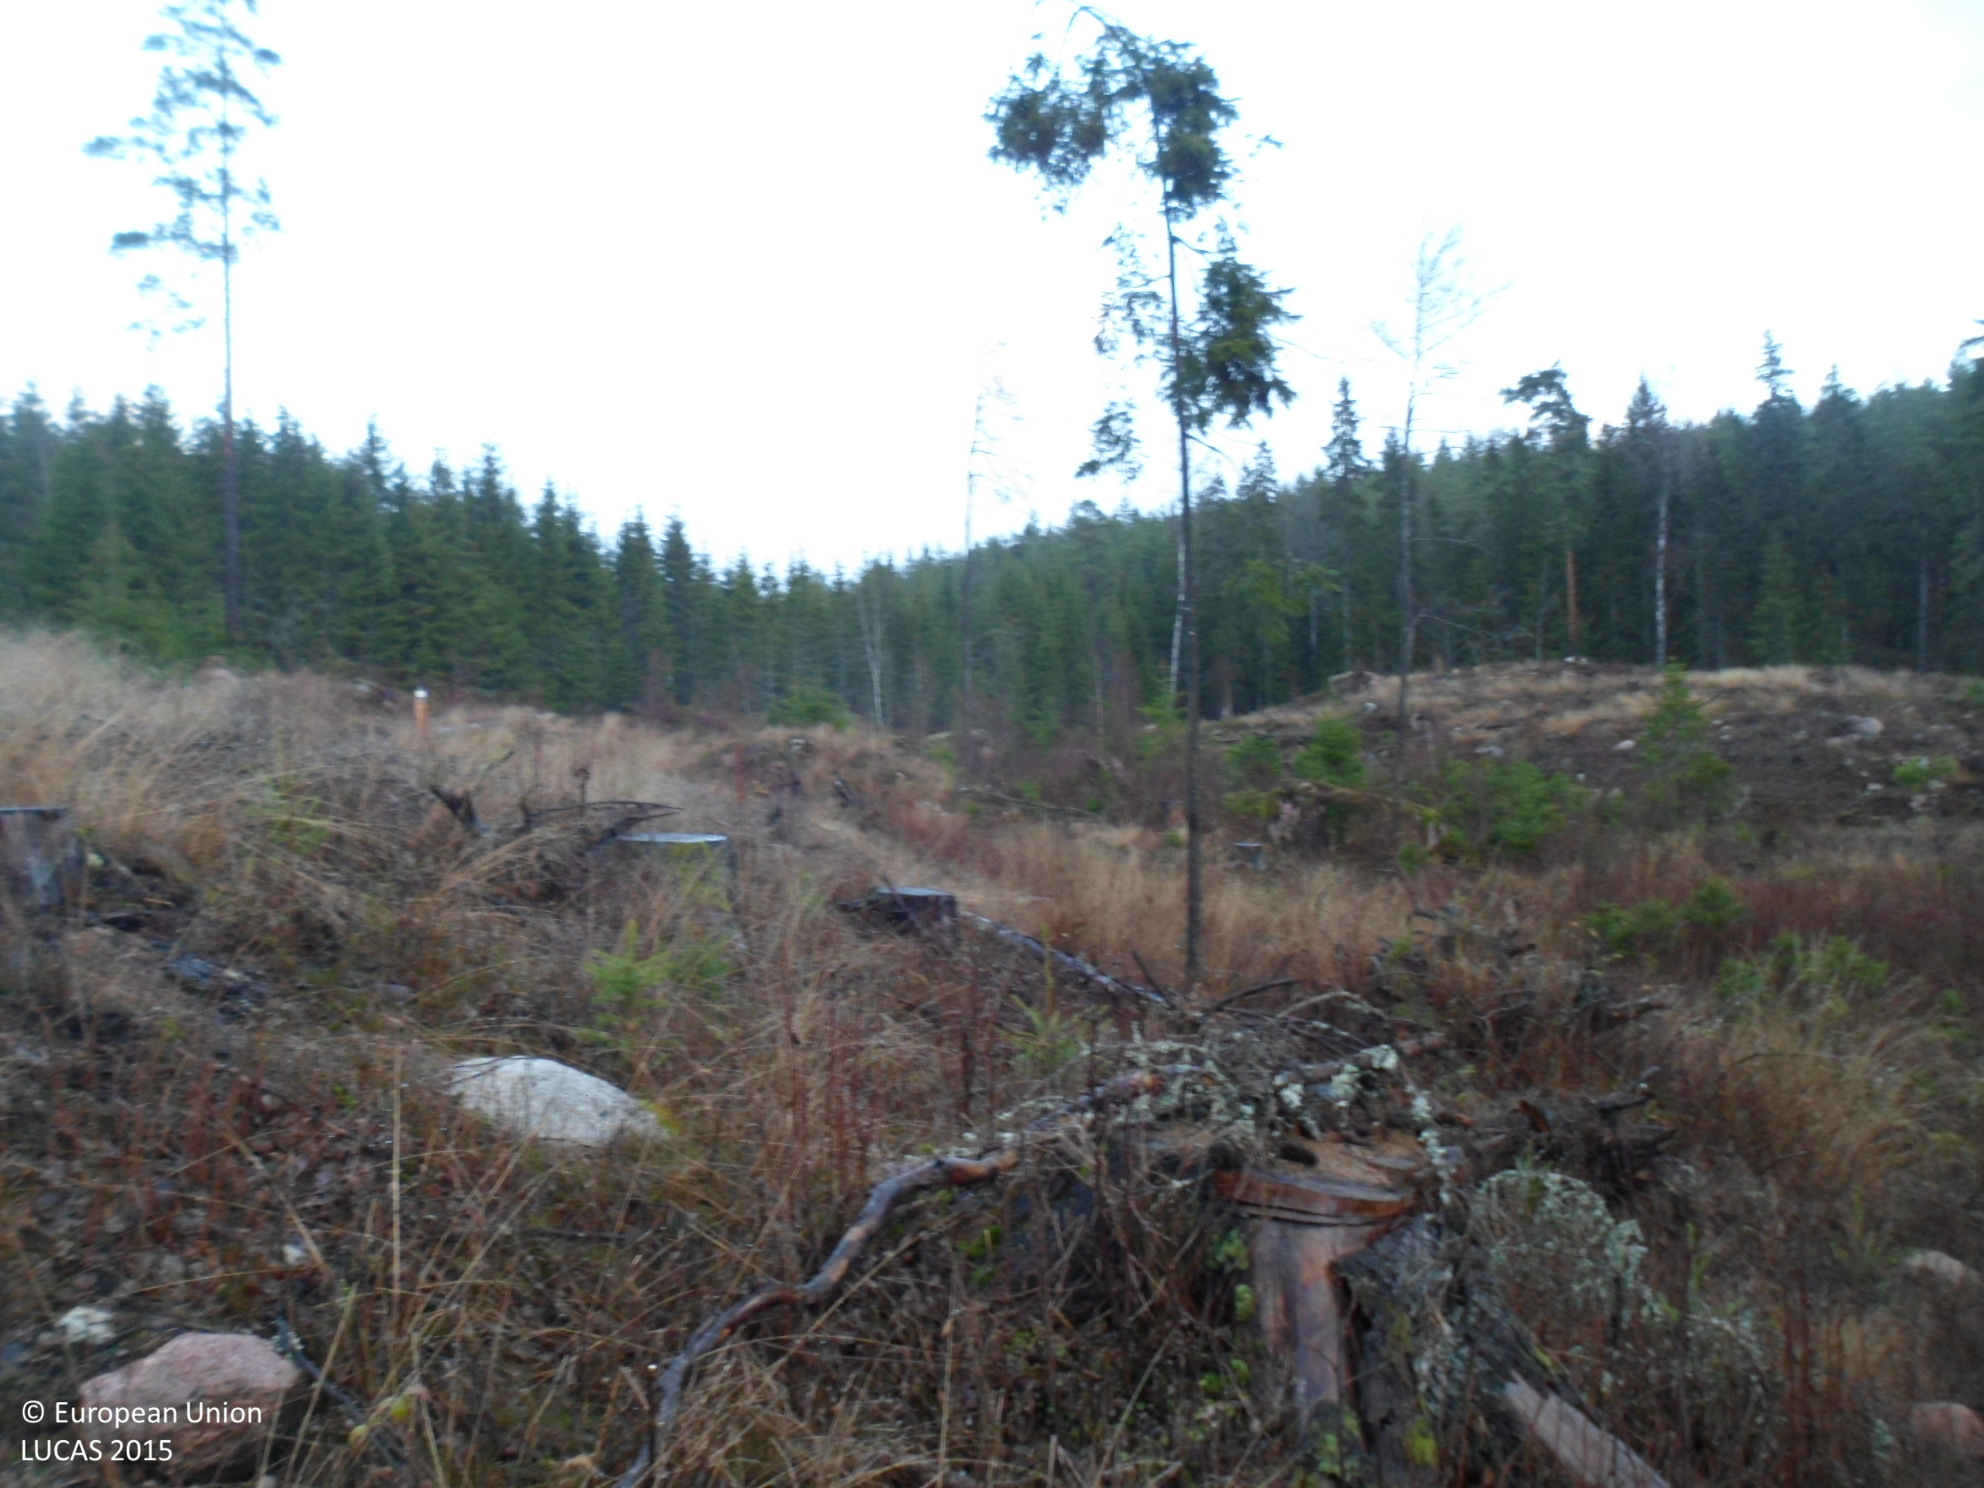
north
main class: Woodland
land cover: Spruce dominated mixed woodland
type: boreal forest
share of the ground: < 10 %
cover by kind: herbaceous plants 40 %, lichens and mosses 30 %, shrubs 10 %, unconsolidated bare surface 10 %, coniferous forest trees 5 %, broadleaved forest trees 5 %
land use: Forestry
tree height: < 5 m
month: November
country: SE
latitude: 57.4887
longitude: 15.1845
